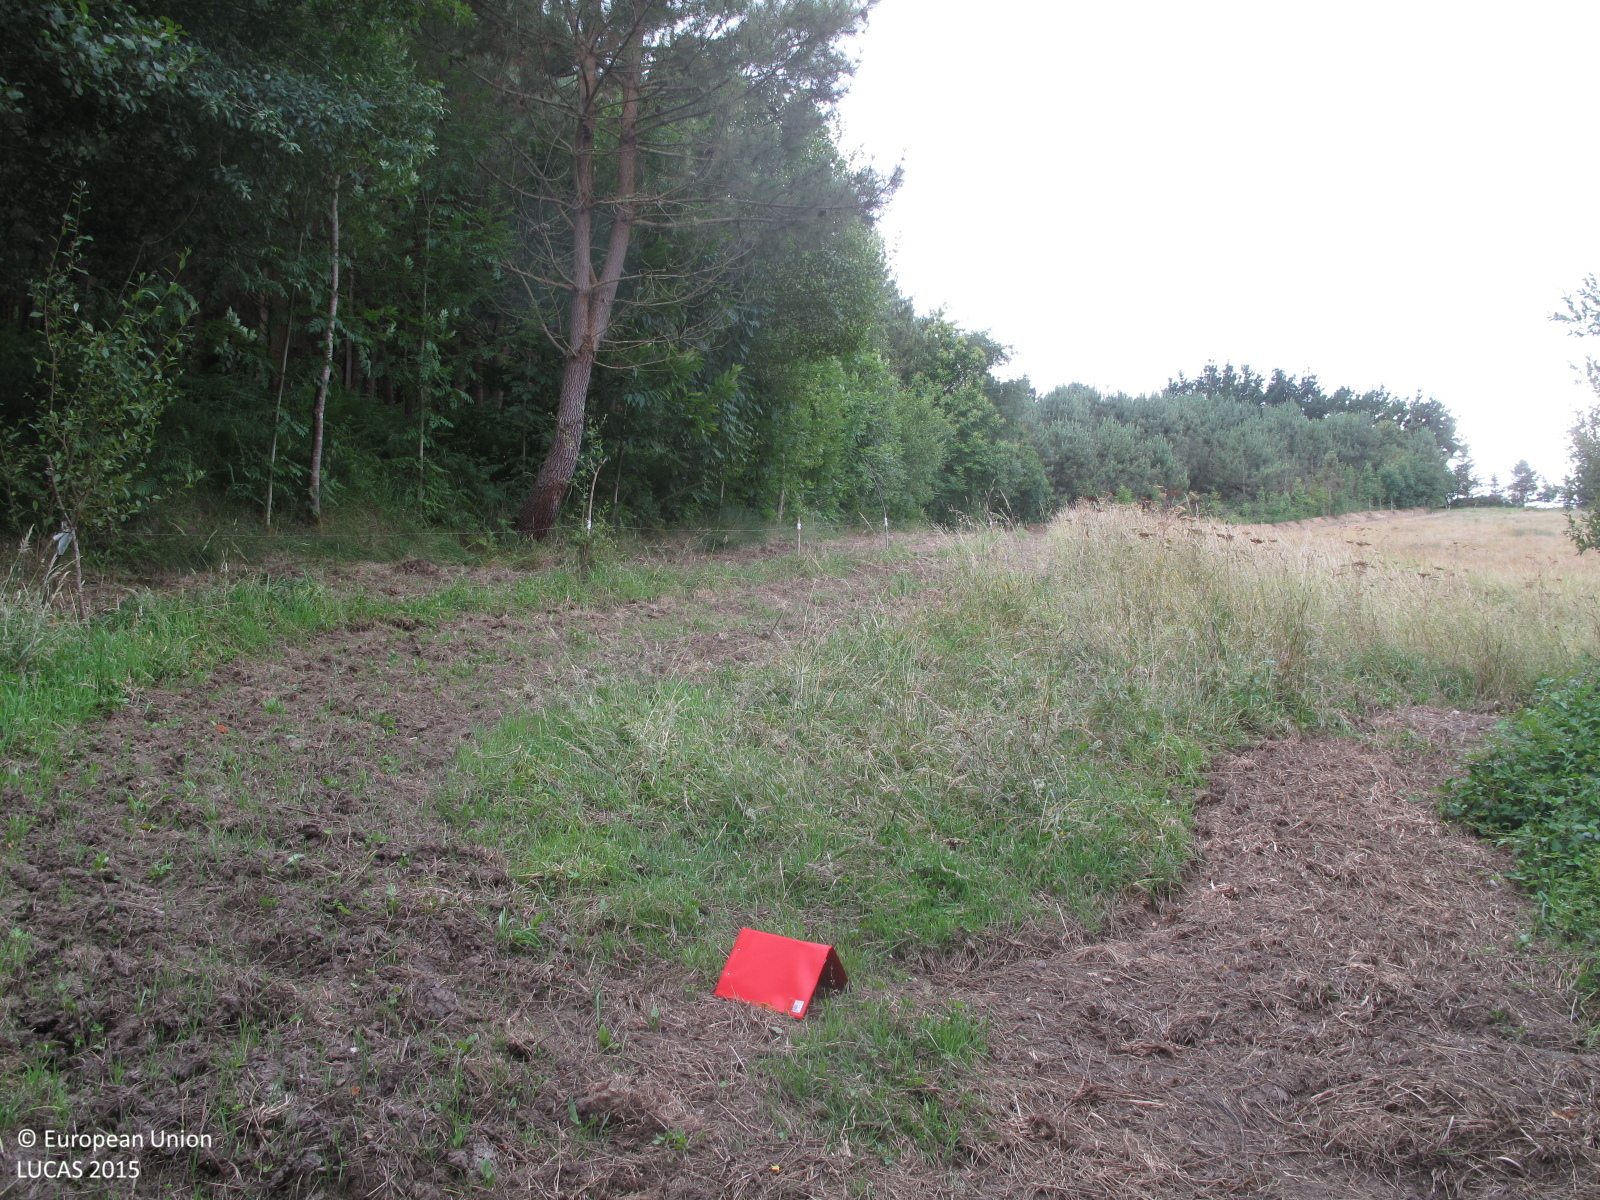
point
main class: Grassland
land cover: Grassland without tree/shrub cover
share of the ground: > 75 %
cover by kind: herbaceous plants 80 %, unconsolidated bare surface 20 %
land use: Agriculture (excluding fallow land and kitchen gardens)
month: July
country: ES
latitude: 43.2293
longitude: -8.5668
